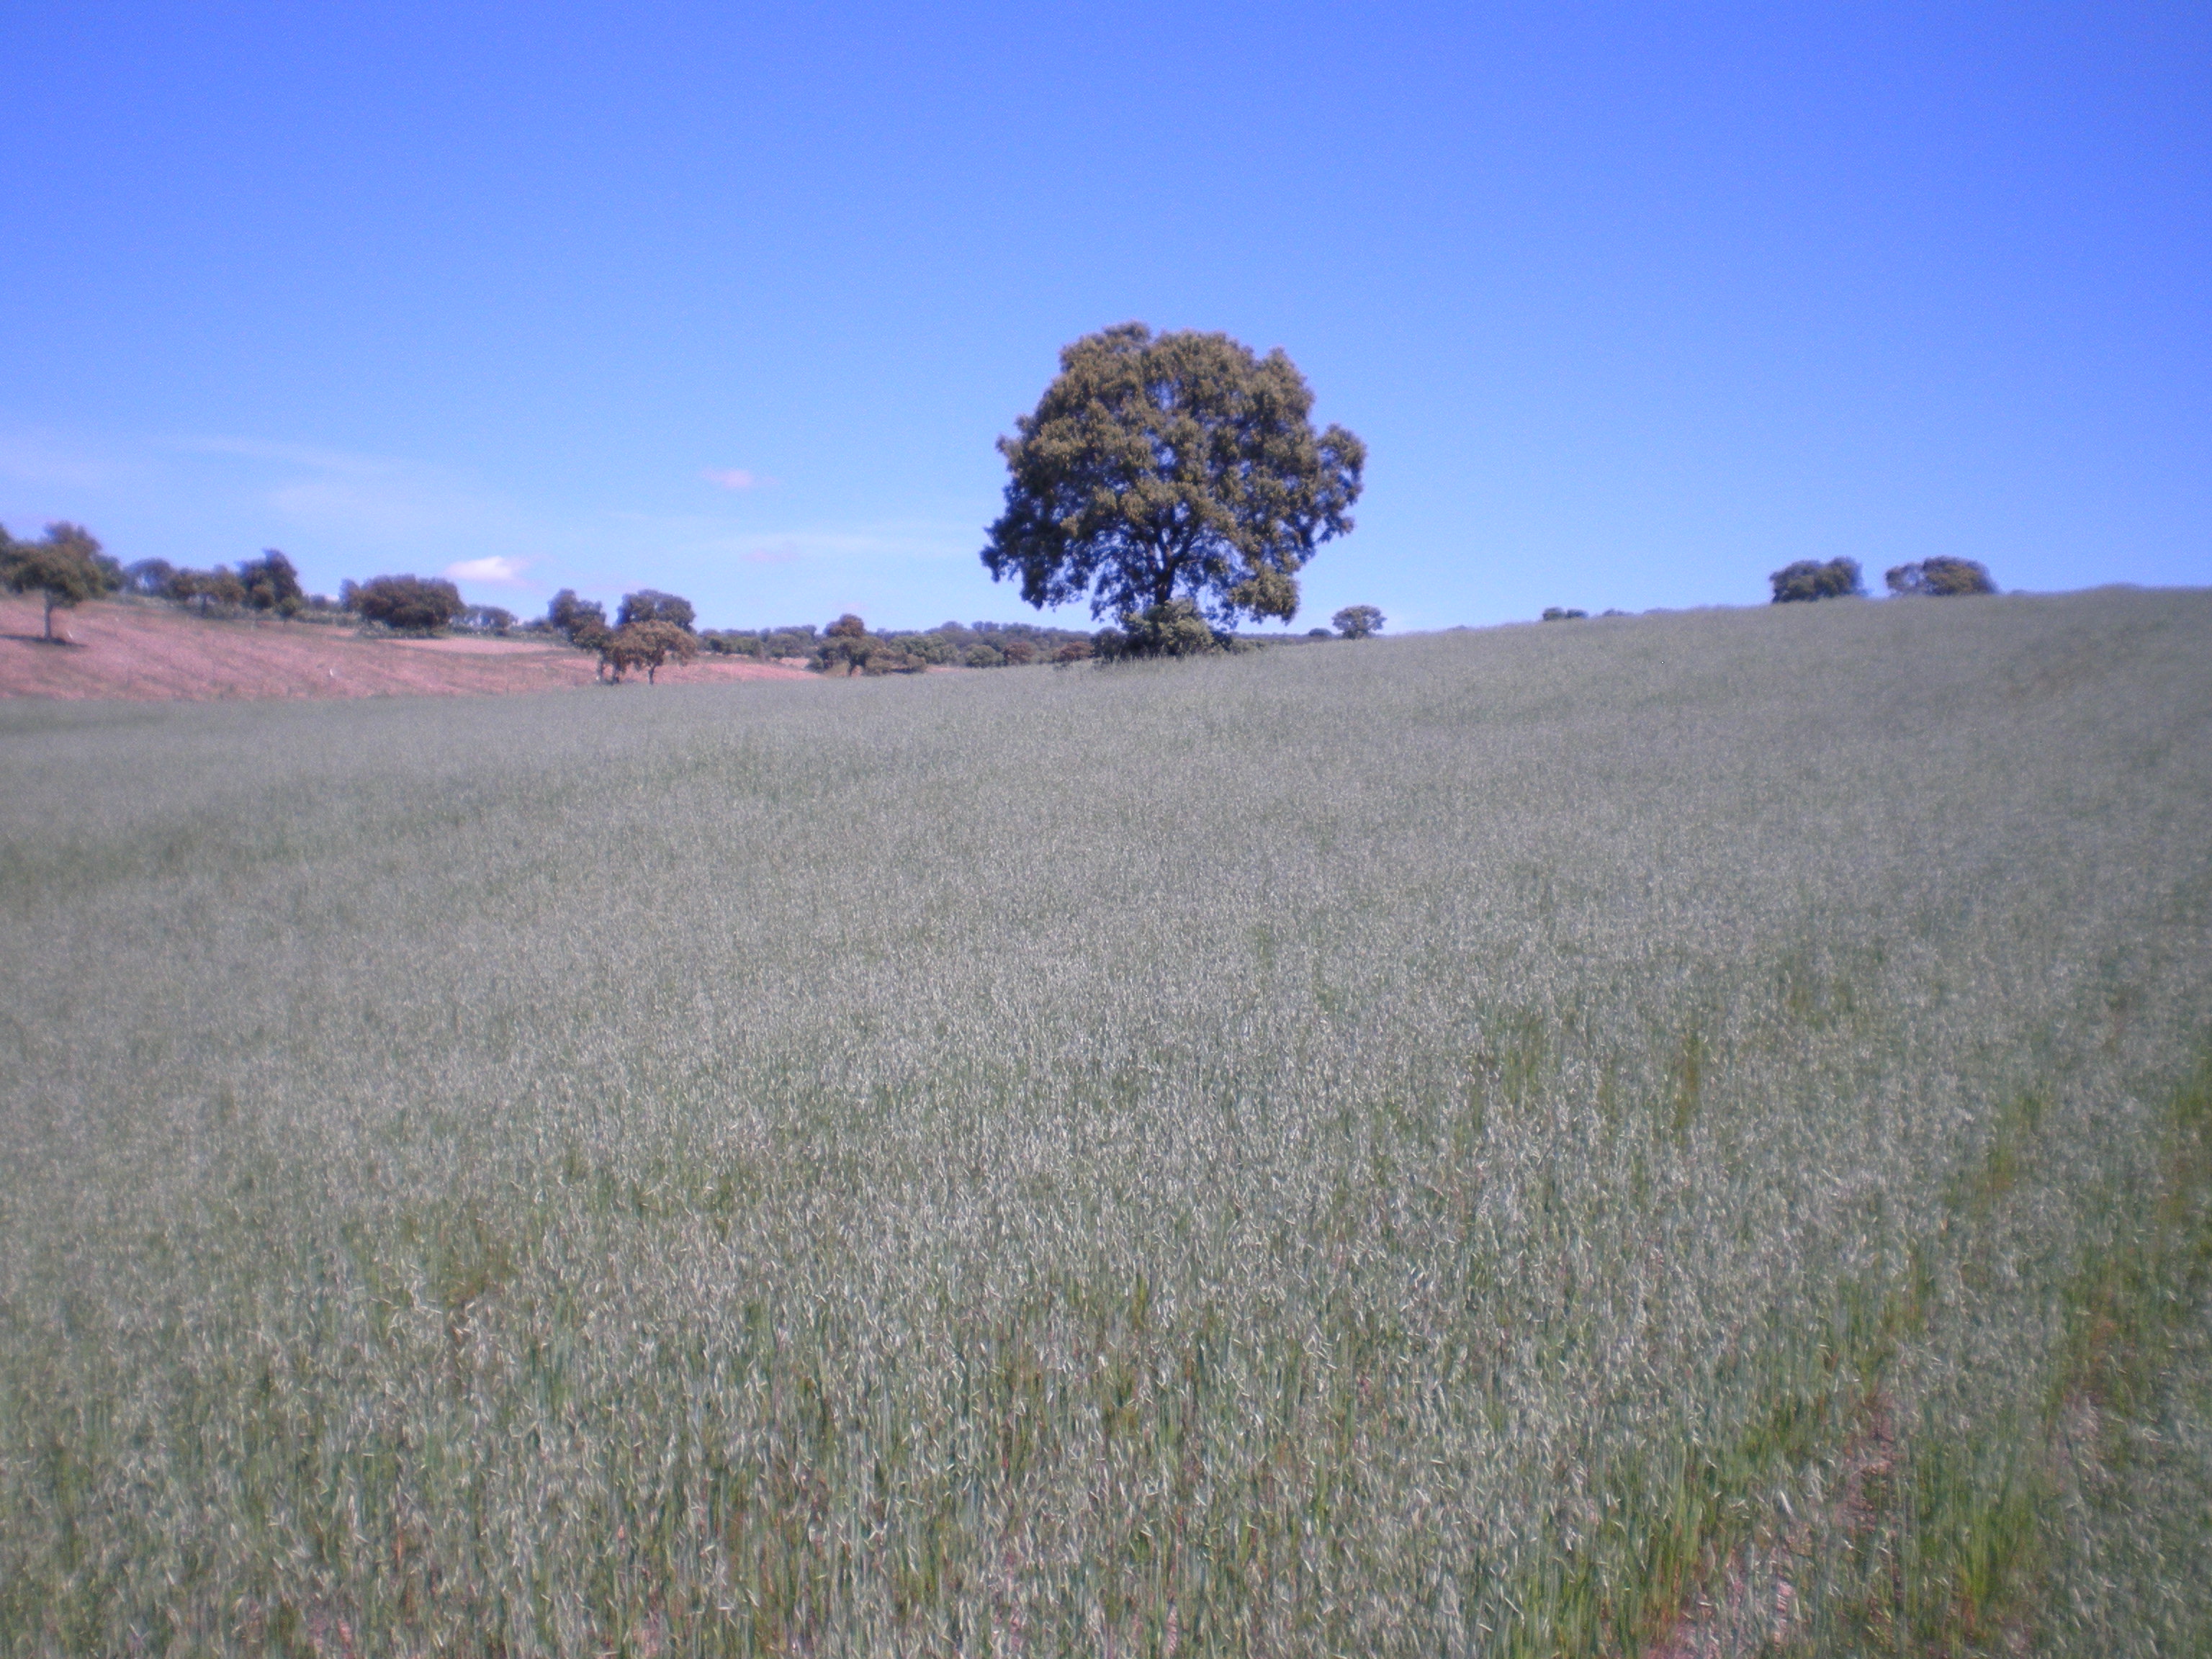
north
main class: Cropland
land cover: Oats
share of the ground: > 75 %
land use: Agriculture (excluding fallow land and kitchen gardens)
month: April
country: ES
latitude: 38.5079
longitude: -2.9500
